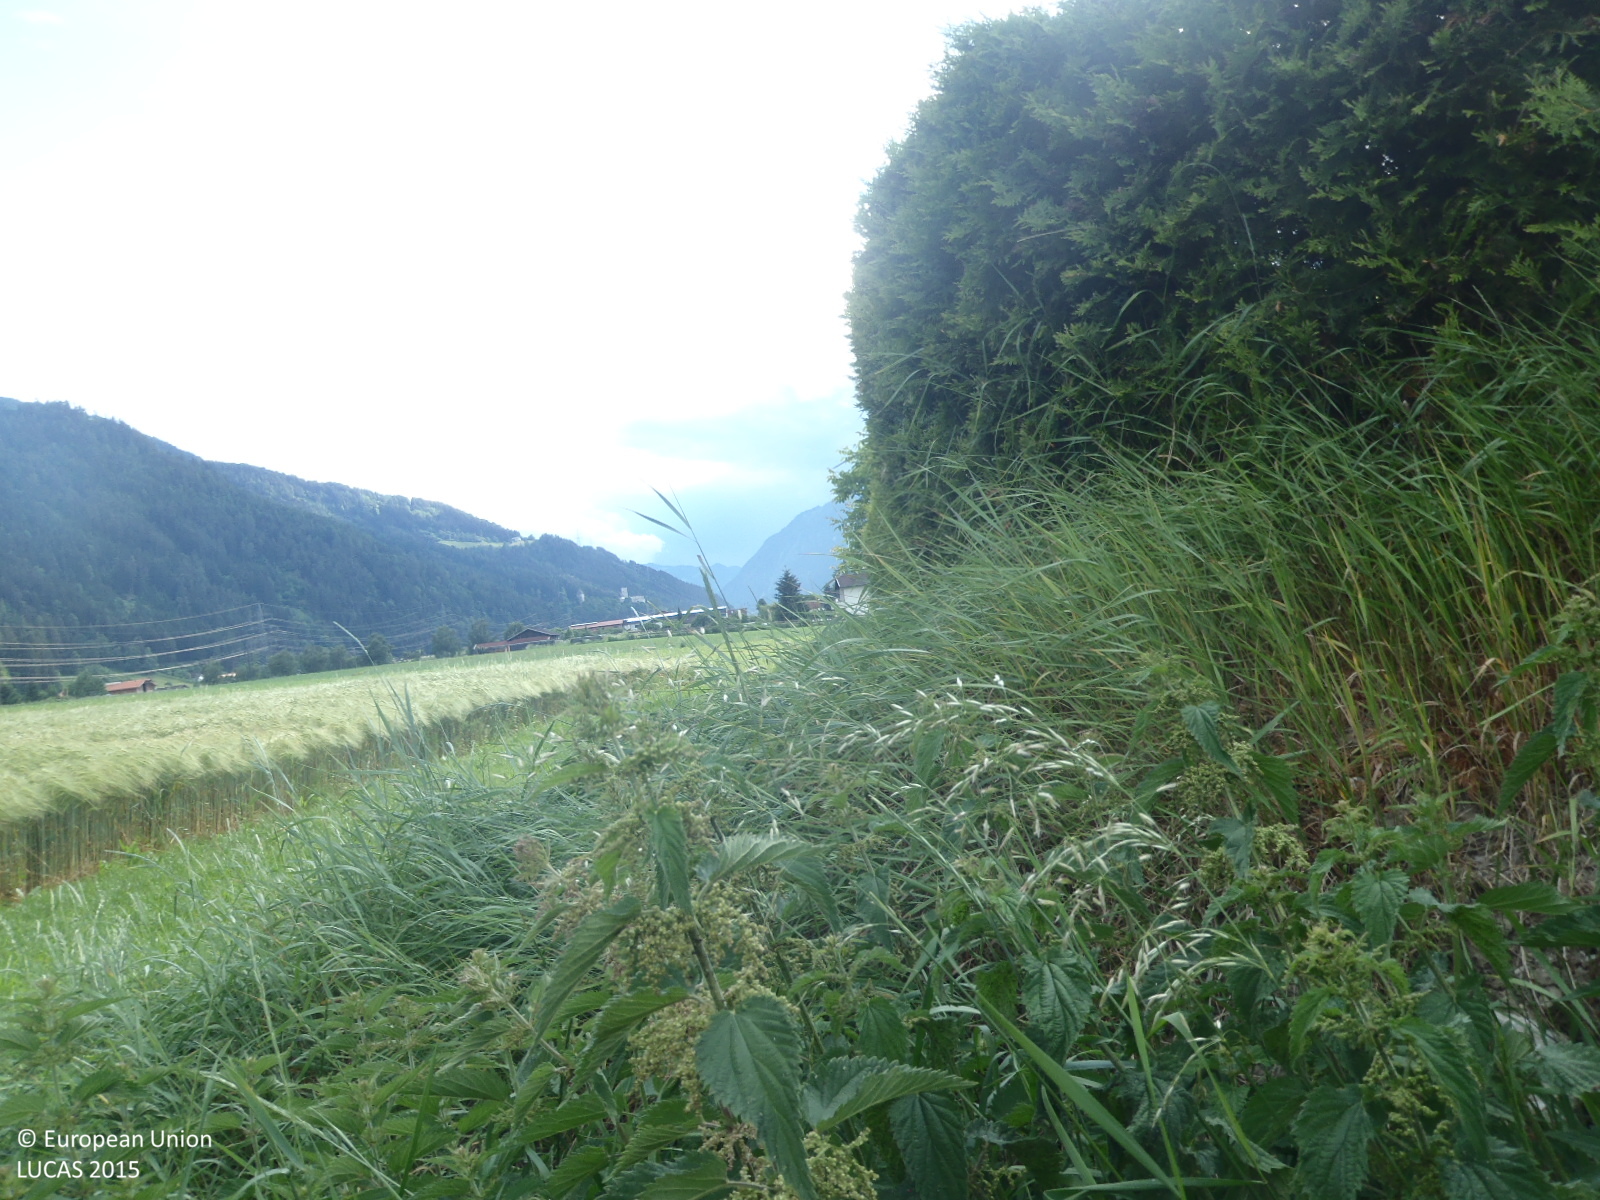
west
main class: Cropland
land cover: Rye
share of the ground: > 75 %
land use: Agriculture (excluding fallow land and kitchen gardens)
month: June
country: AT
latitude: 47.2655
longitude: 10.9375
